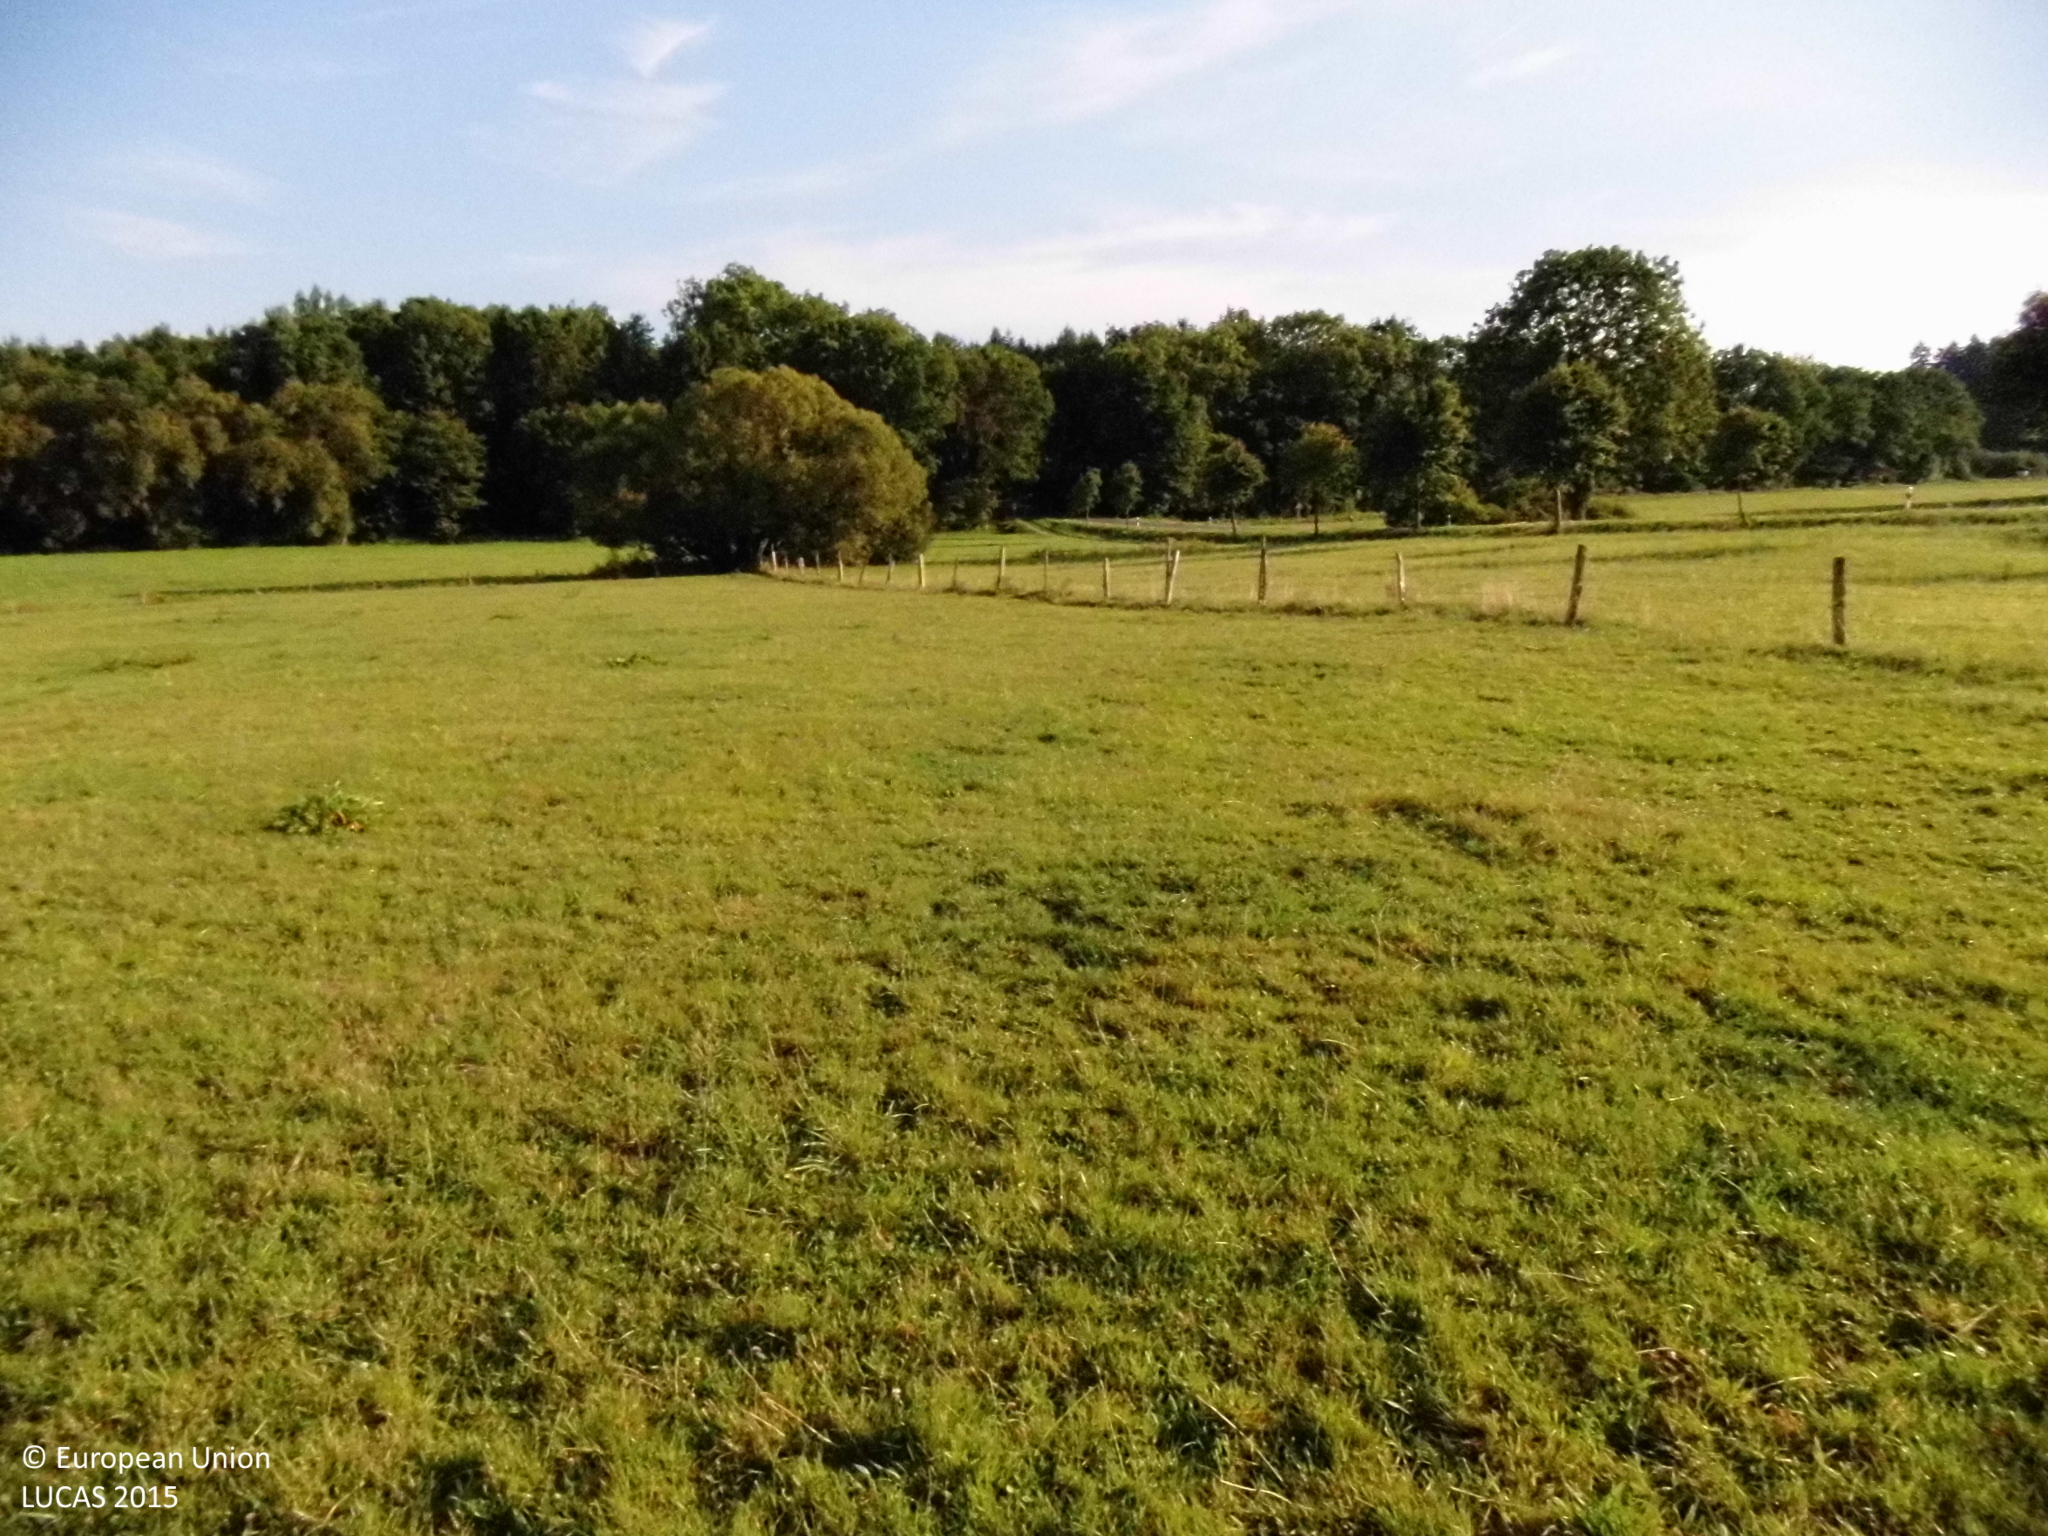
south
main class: Grassland
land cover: Grassland without tree/shrub cover
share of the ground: > 75 %
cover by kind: herbaceous plants 100 %
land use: Agriculture (excluding fallow land and kitchen gardens)
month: August
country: DE
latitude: 50.4921
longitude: 8.0974
